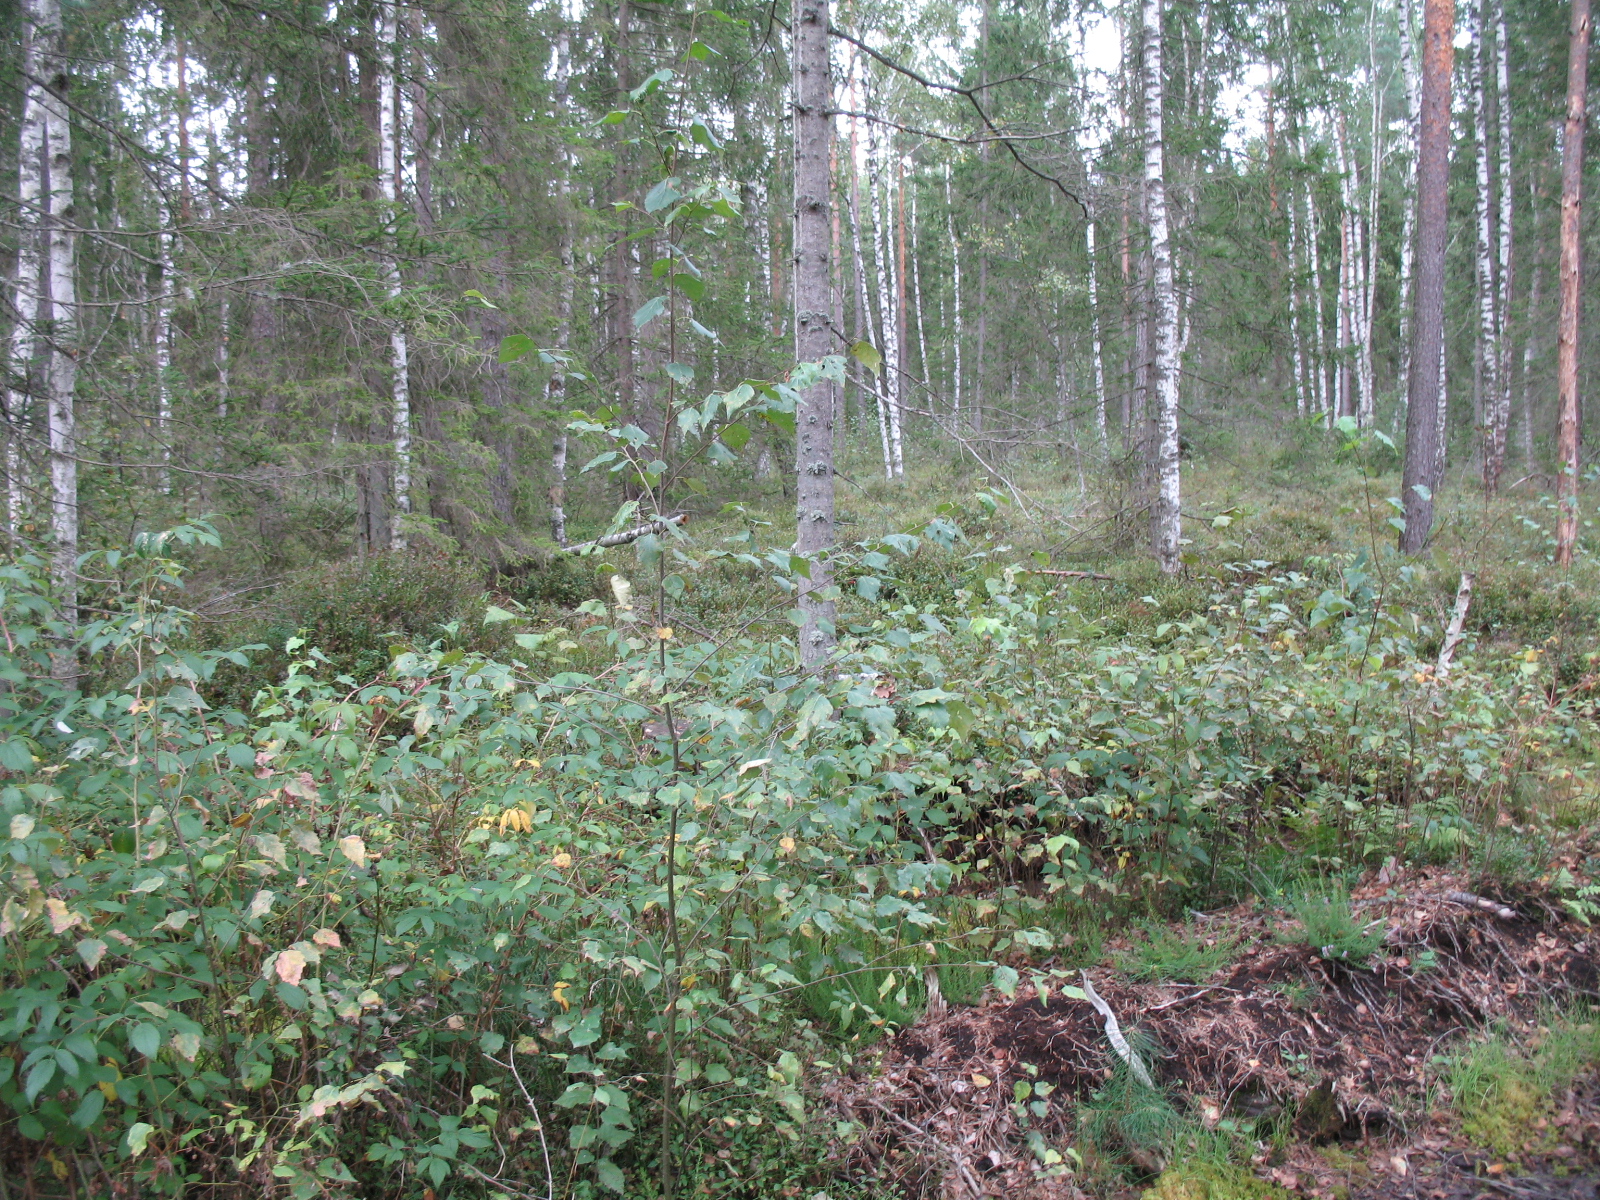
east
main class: Woodland
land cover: Other mixed woodland
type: hemiboreal forest and nemoral coniferous forest and mixed broadleaved-coniferous forest
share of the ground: 25 - 50 %
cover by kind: coniferous forest trees 25 %, herbaceous plants 25 %, lichens and mosses 25 %, broadleaved forest trees 20 %, shrubs 5 %
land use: Forestry
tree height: > 5 m
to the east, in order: Other mixed woodland; Spruce dominated mixed woodland; Other mixed woodland; Spruce dominated mixed woodland
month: September
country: LV
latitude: 56.1531
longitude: 25.9589
